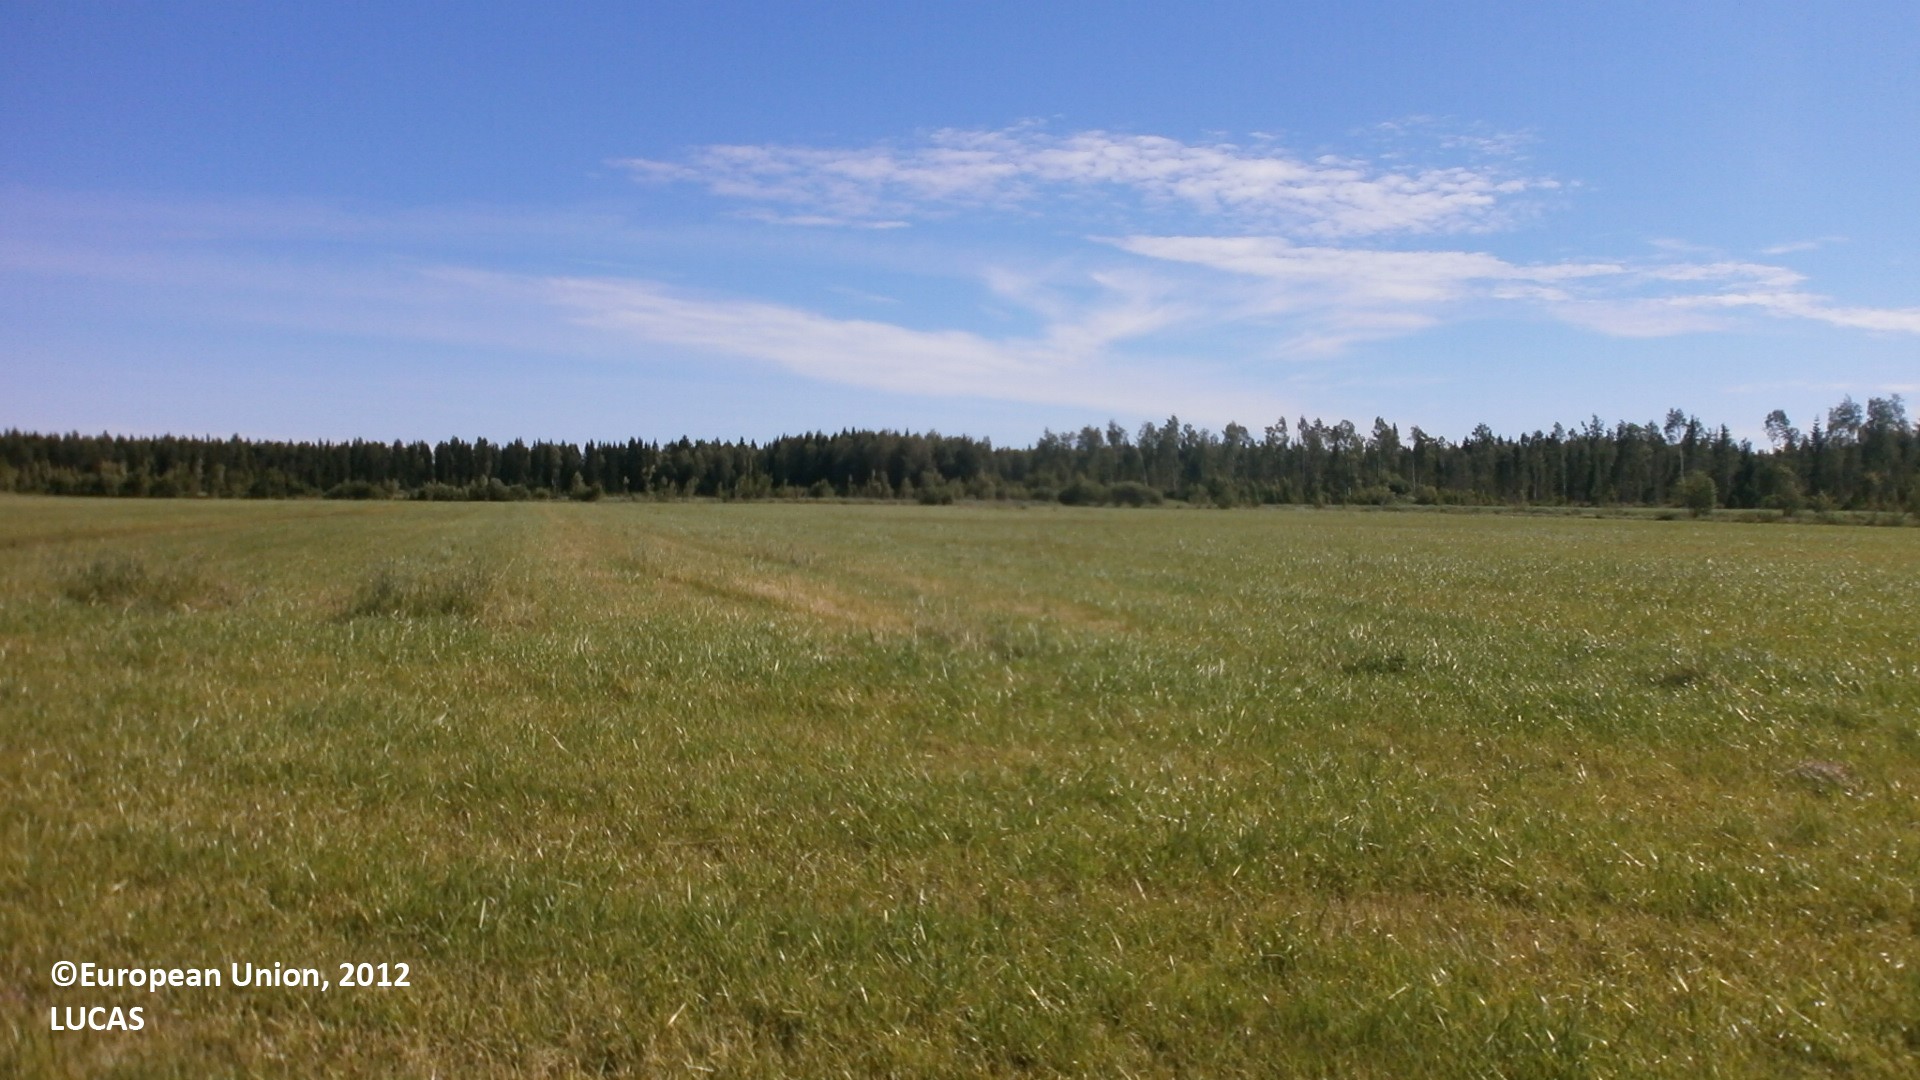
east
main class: Cropland
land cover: Temporary grasslands
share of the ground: > 75 %
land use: Agriculture (excluding fallow land and kitchen gardens)
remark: Harvested field
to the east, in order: Temporary grasslands; Abandoned hedges; Ditches and canals; Shruby margins; Temporary grasslands
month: July
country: FI
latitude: 64.3763
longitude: 24.0516
